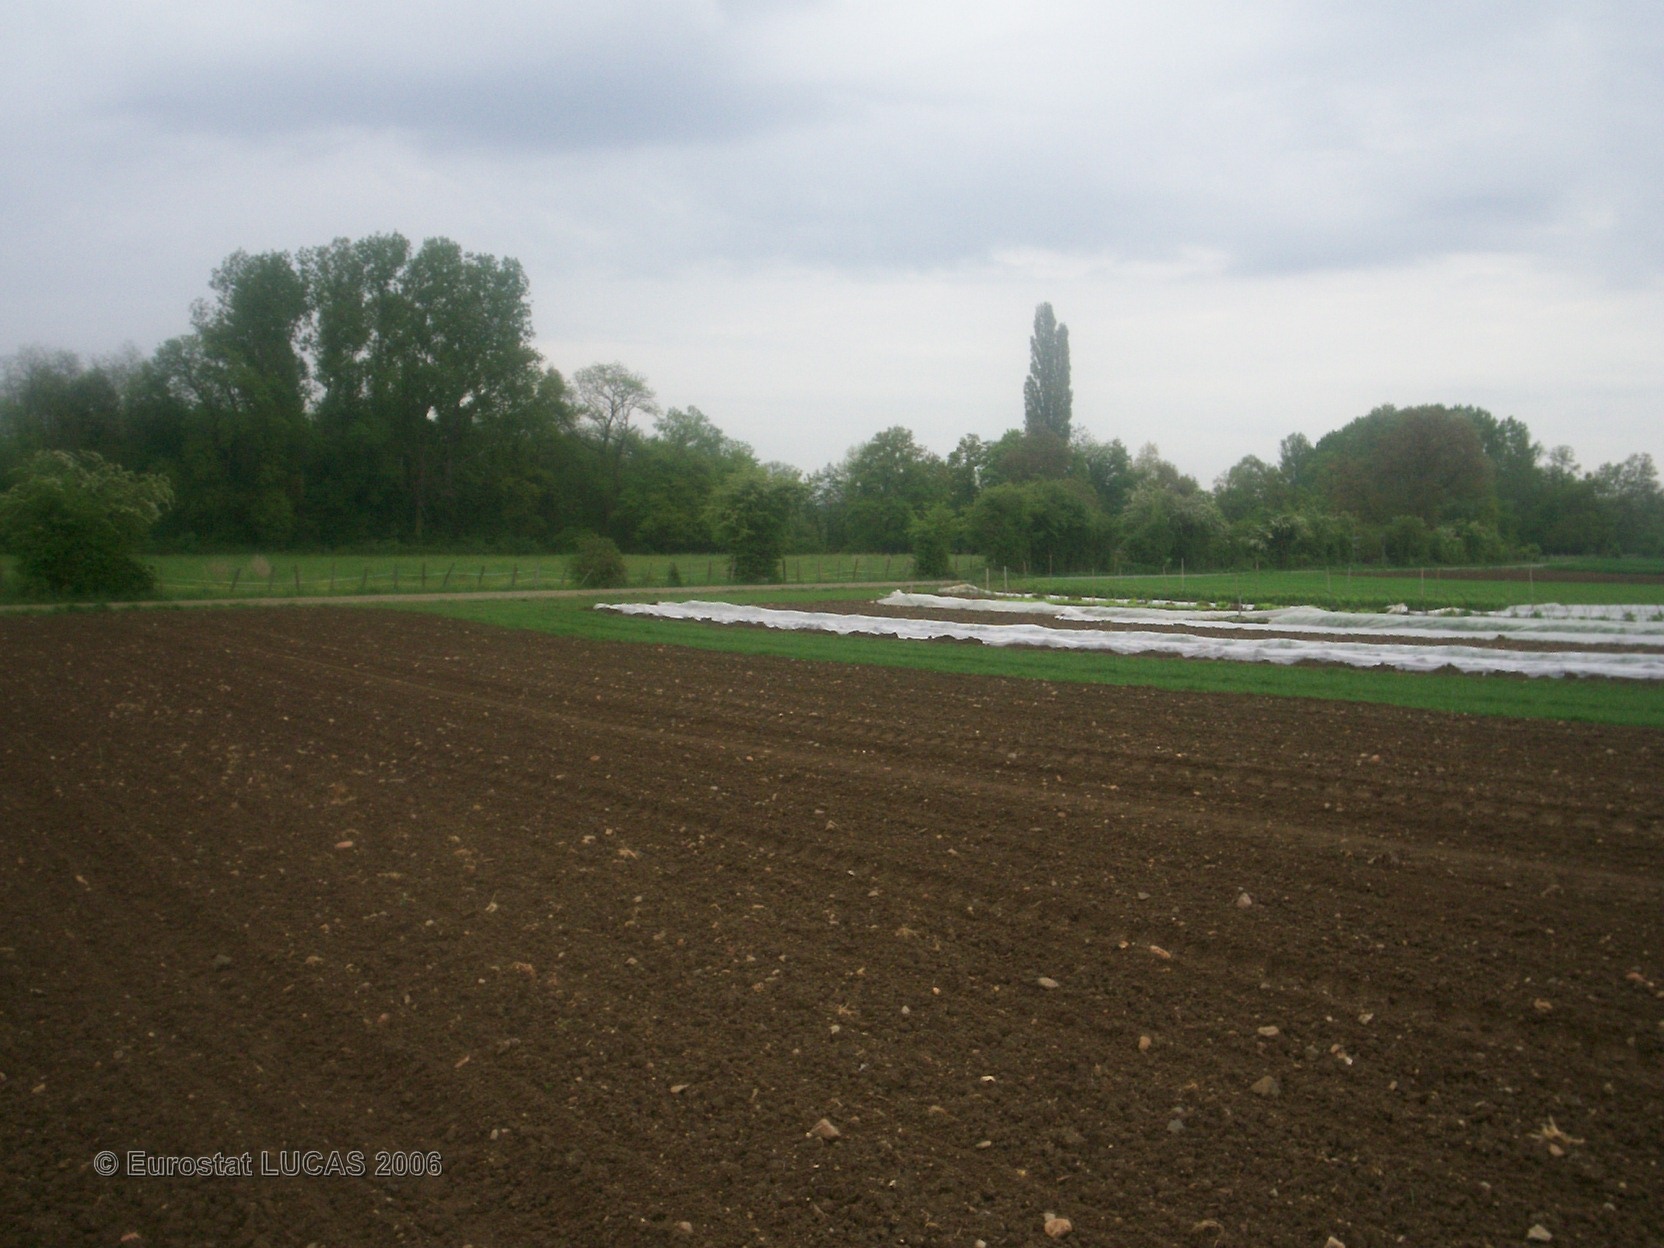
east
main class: Cropland
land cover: Maize
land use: Agriculture (excluding fallow land and kitchen gardens)
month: May
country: FR
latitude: 45.9866
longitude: 3.1444
